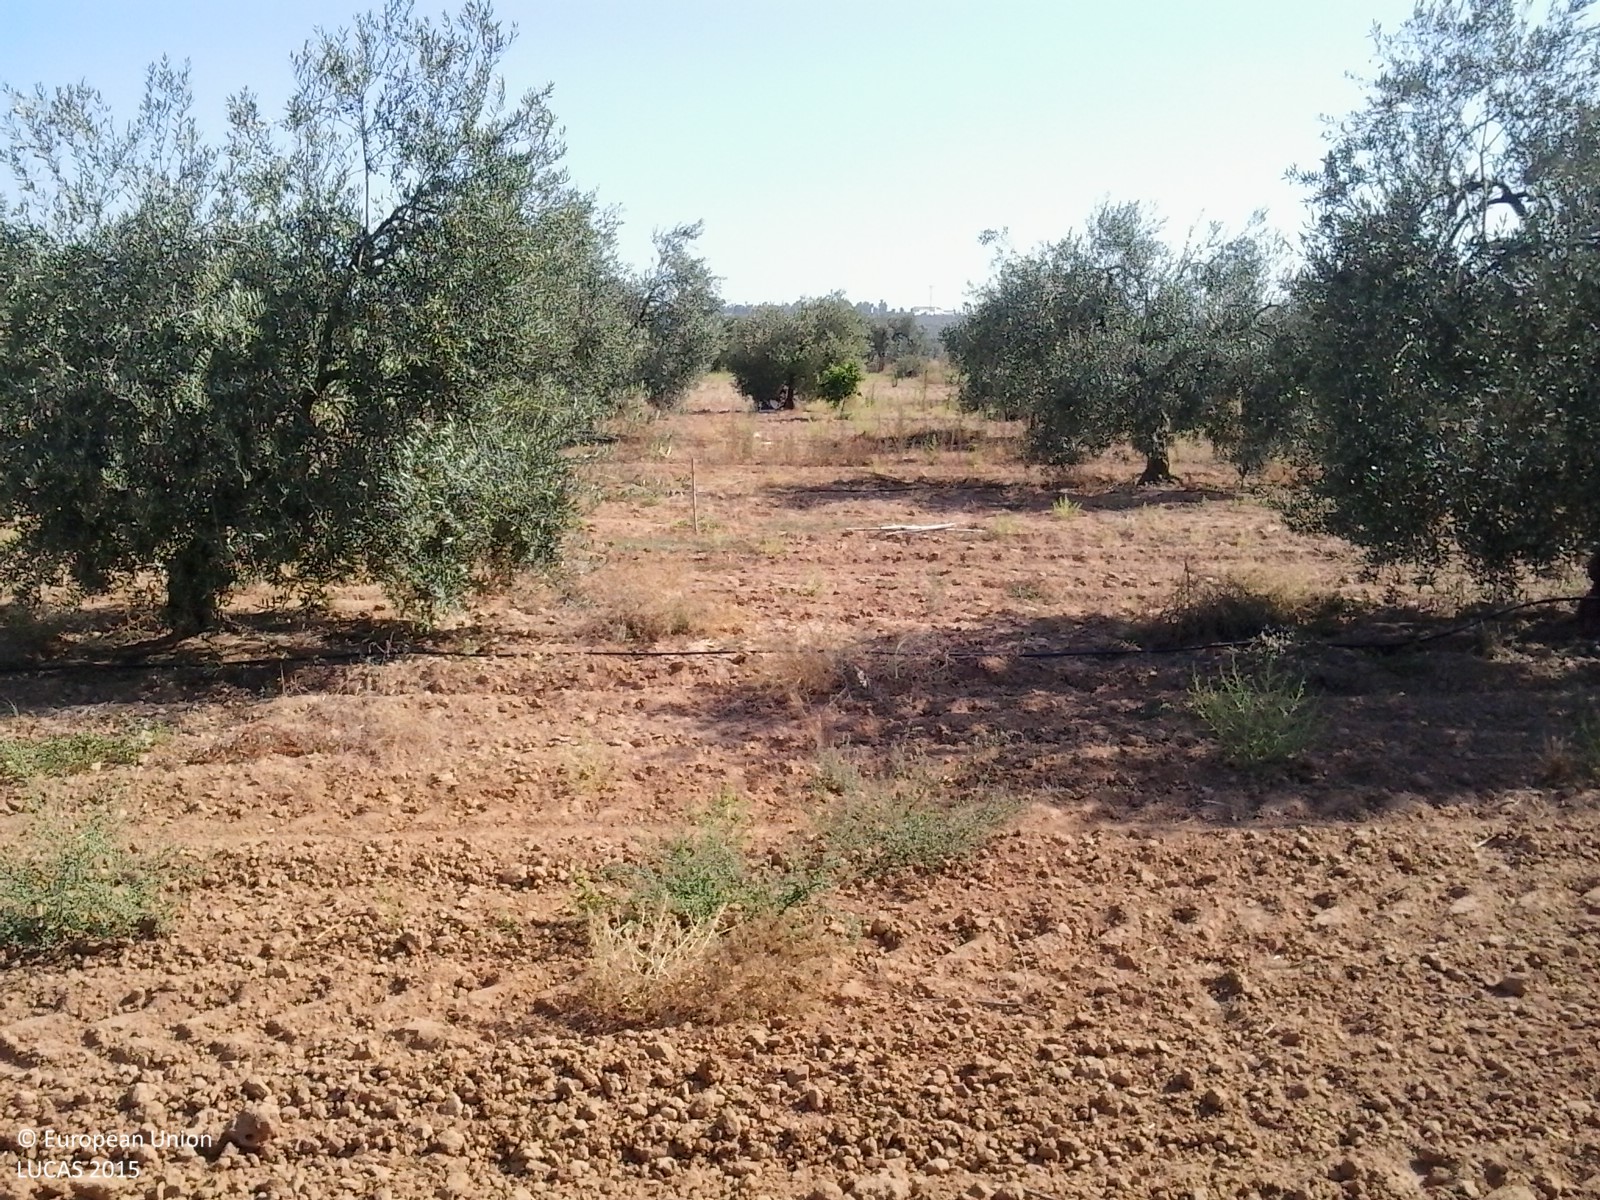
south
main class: Cropland
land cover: Olive groves
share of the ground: 25 - 50 %
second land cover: Other bare soil
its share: > 75 %
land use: Agriculture (excluding fallow land and kitchen gardens)
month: June
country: ES
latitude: 37.3627
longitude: -6.4135
